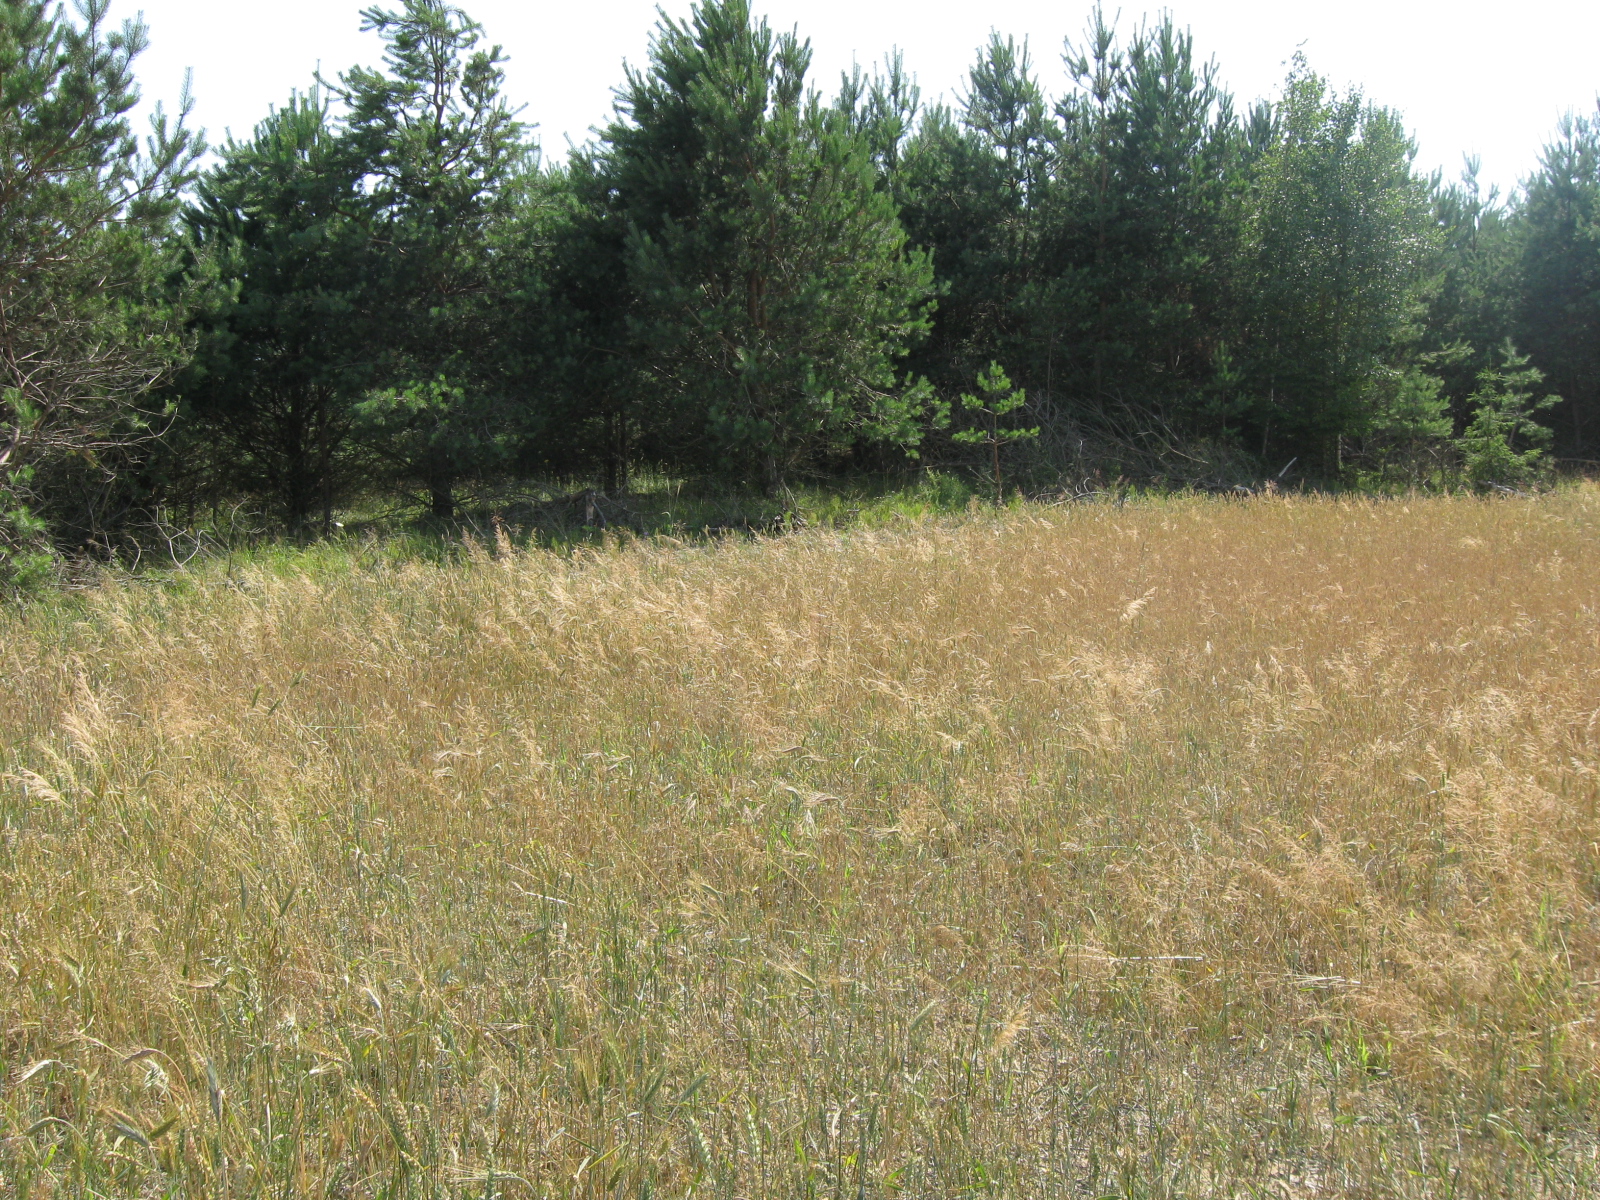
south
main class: Cropland
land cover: Common wheat
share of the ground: > 75 %
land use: Agriculture (excluding fallow land and kitchen gardens)
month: July
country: LT
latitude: 54.6761
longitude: 23.9075
